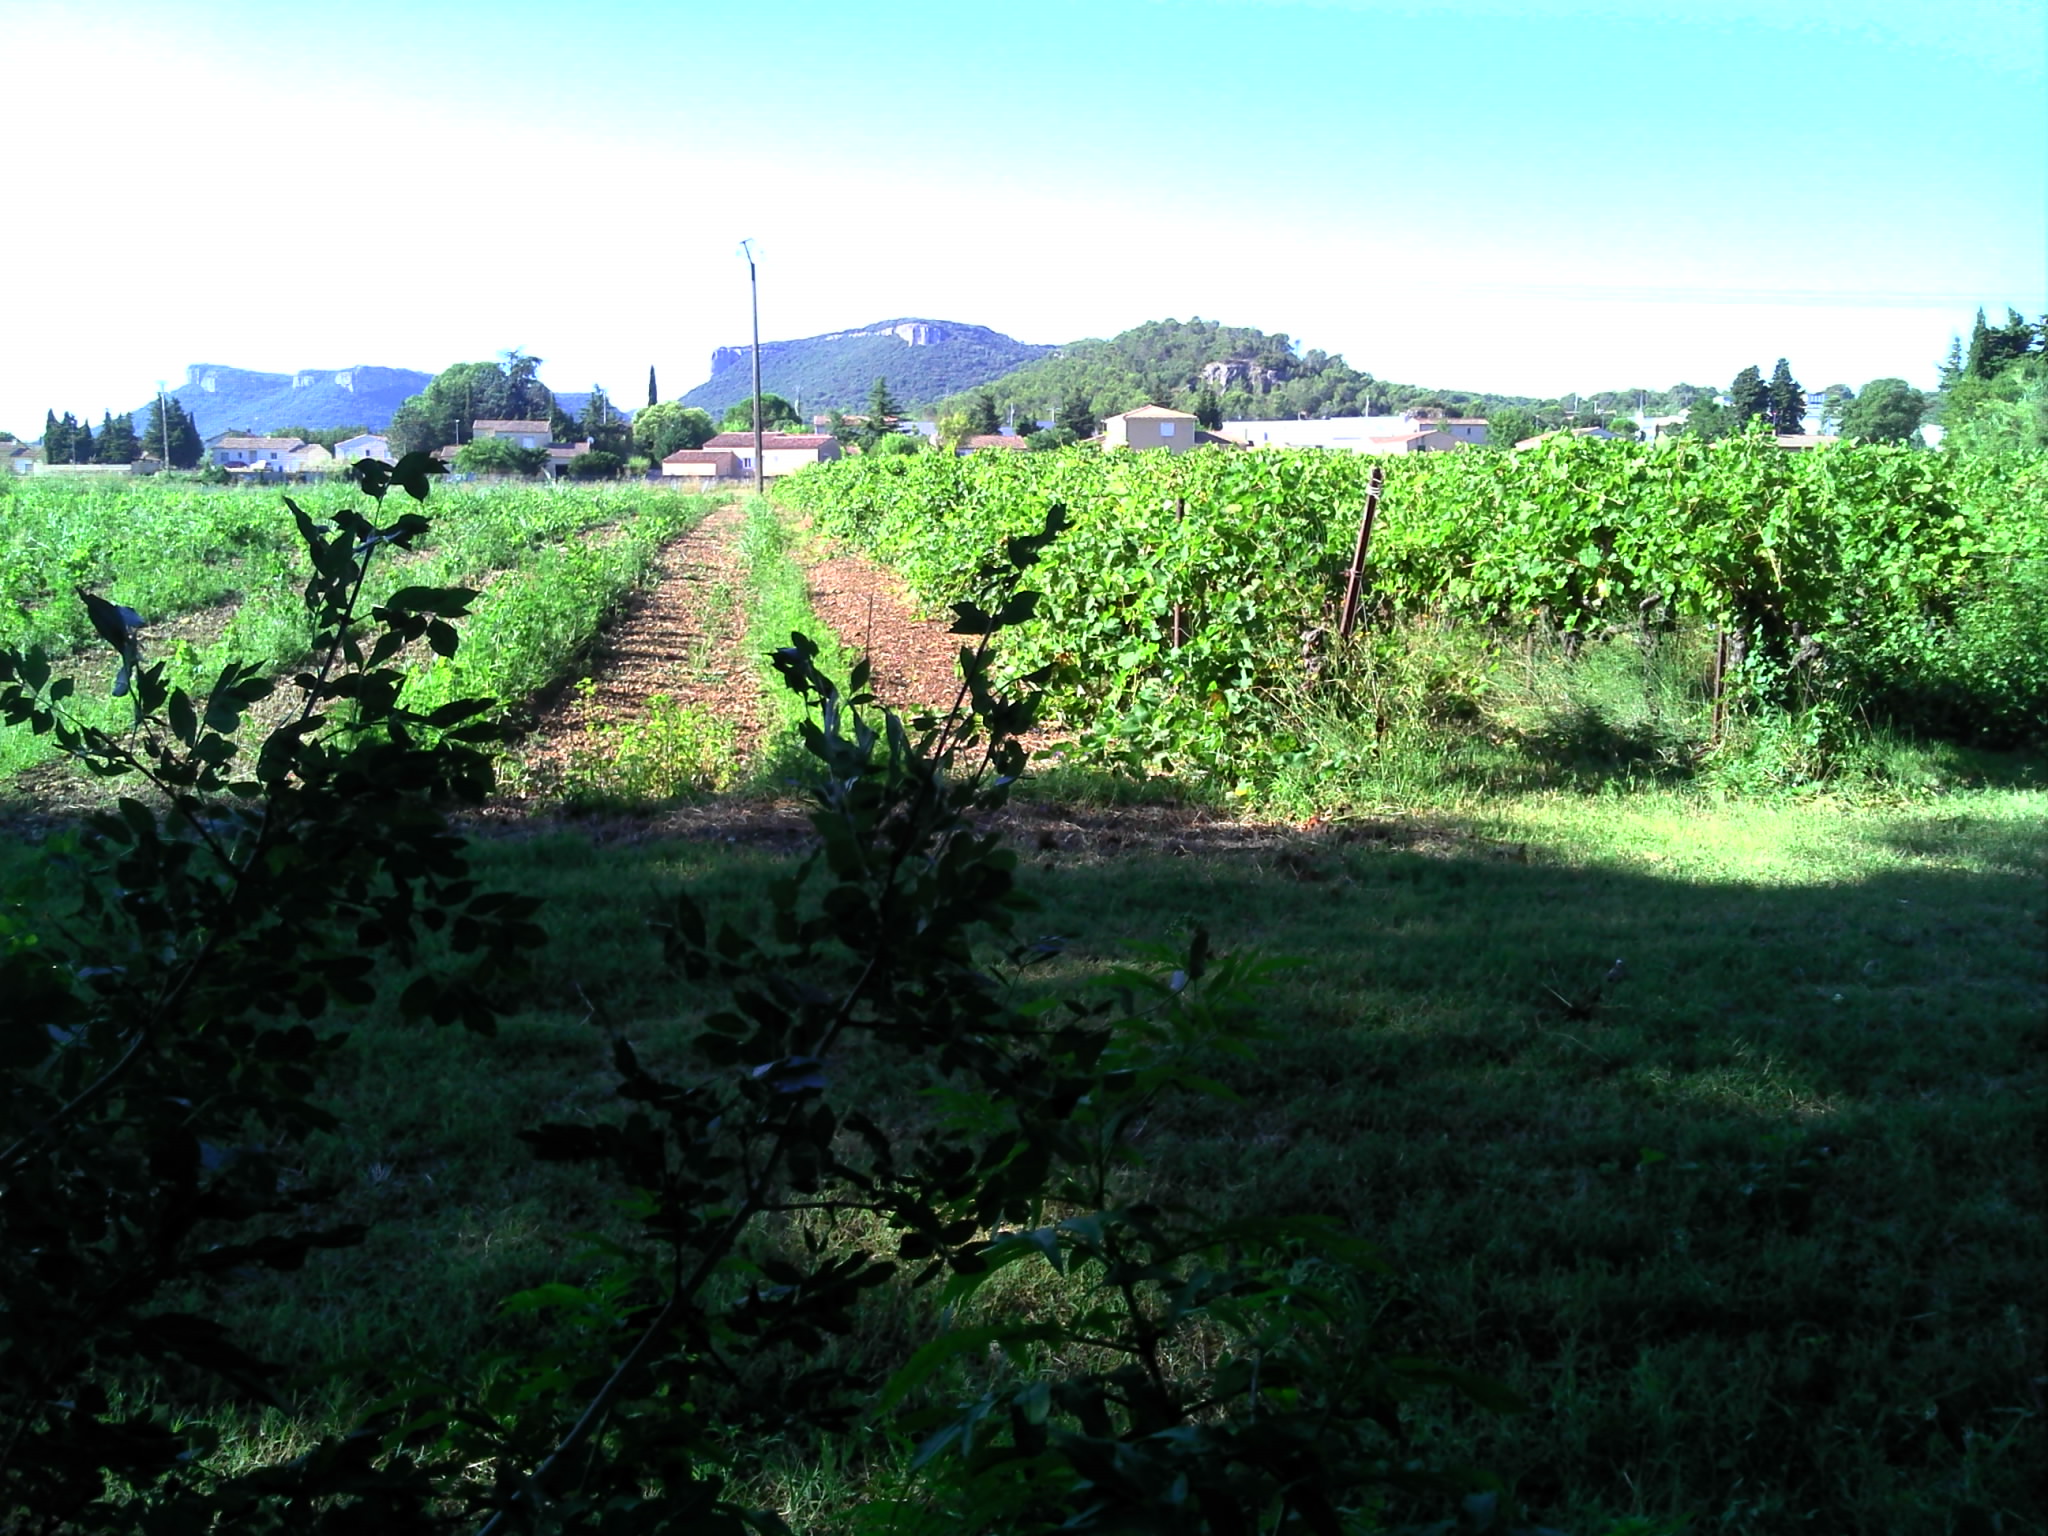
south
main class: Woodland
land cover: Broadleaved woodland
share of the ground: > 75 %
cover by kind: broadleaved forest trees 70 %, herbaceous plants 20 %, consolidated bare surface 10 %
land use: Semi-natural and natural areas not in use
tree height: > 5 m
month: August
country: FR
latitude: 44.1580
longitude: 4.6436
